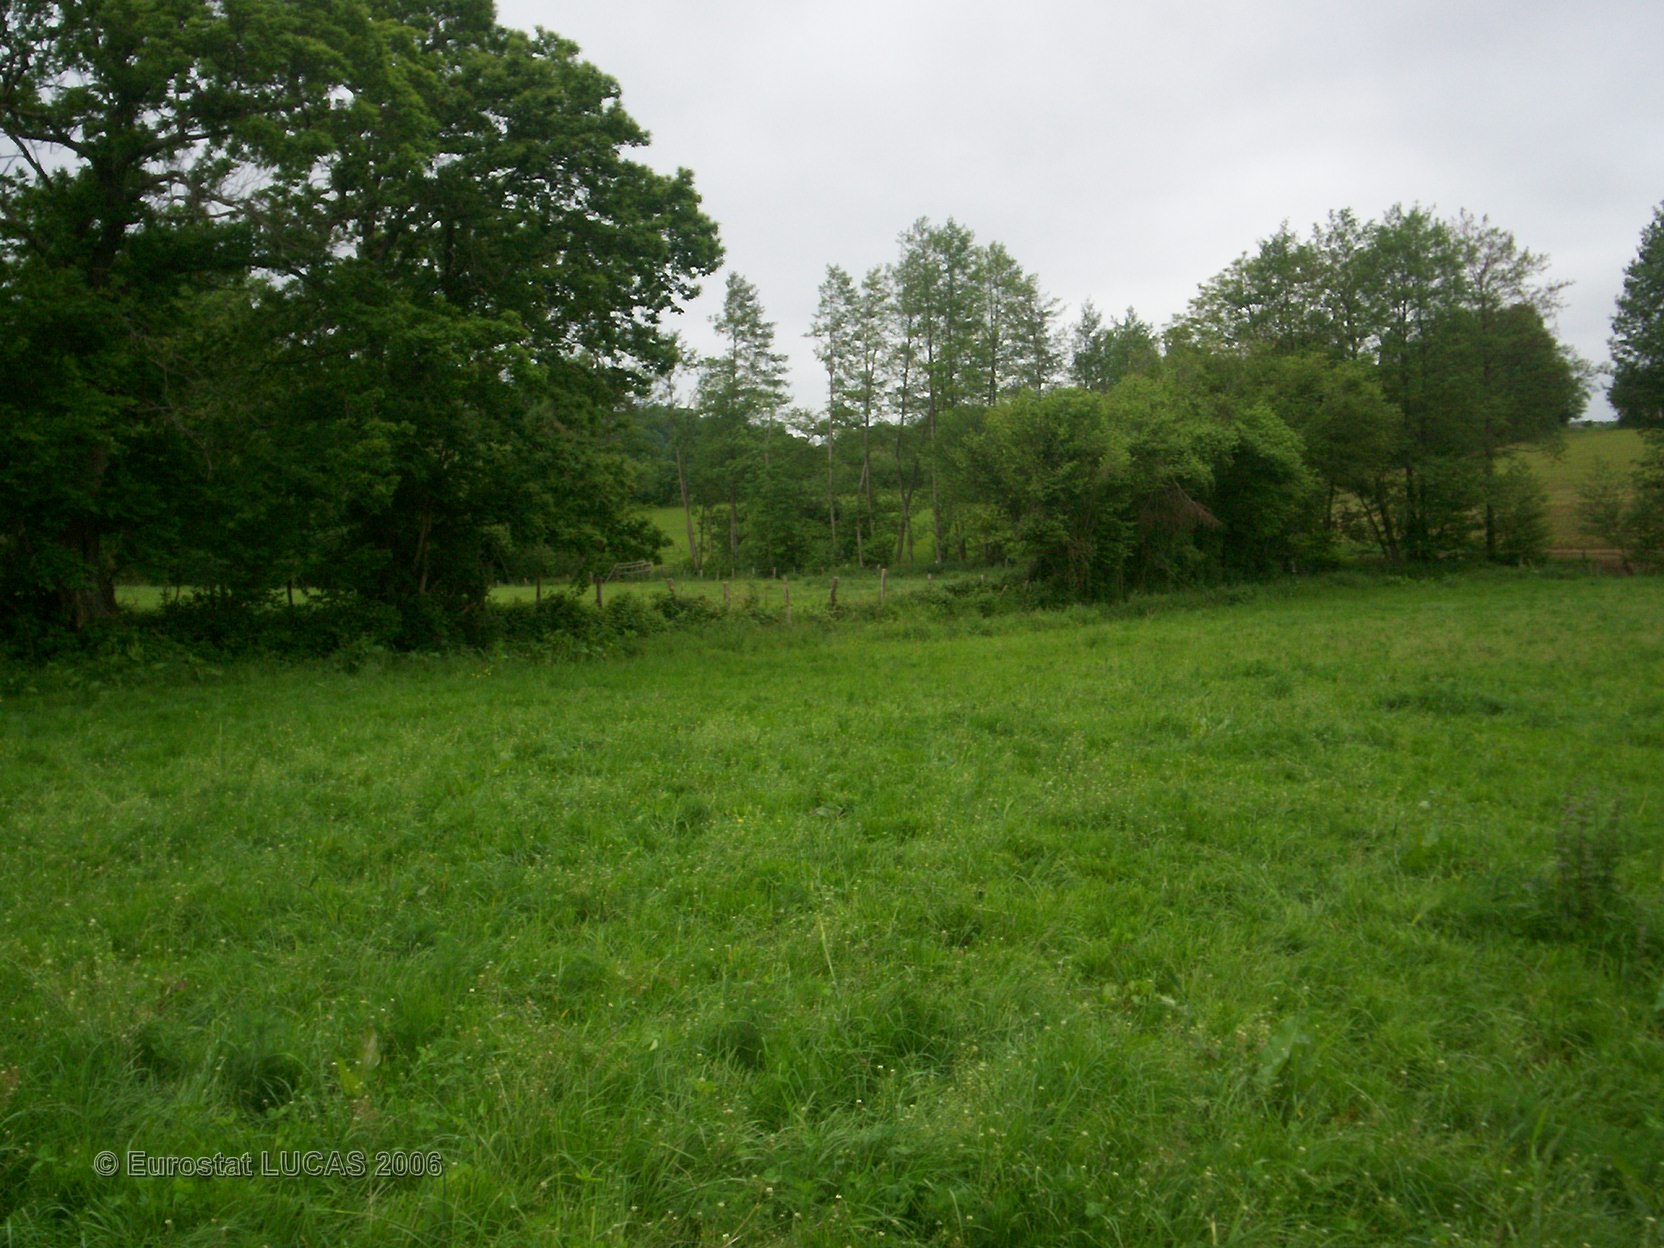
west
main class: Grassland
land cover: Grassland without tree/shrub cover
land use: Agriculture (excluding fallow land and kitchen gardens)
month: May
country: FR
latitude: 48.4300
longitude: 0.3103
